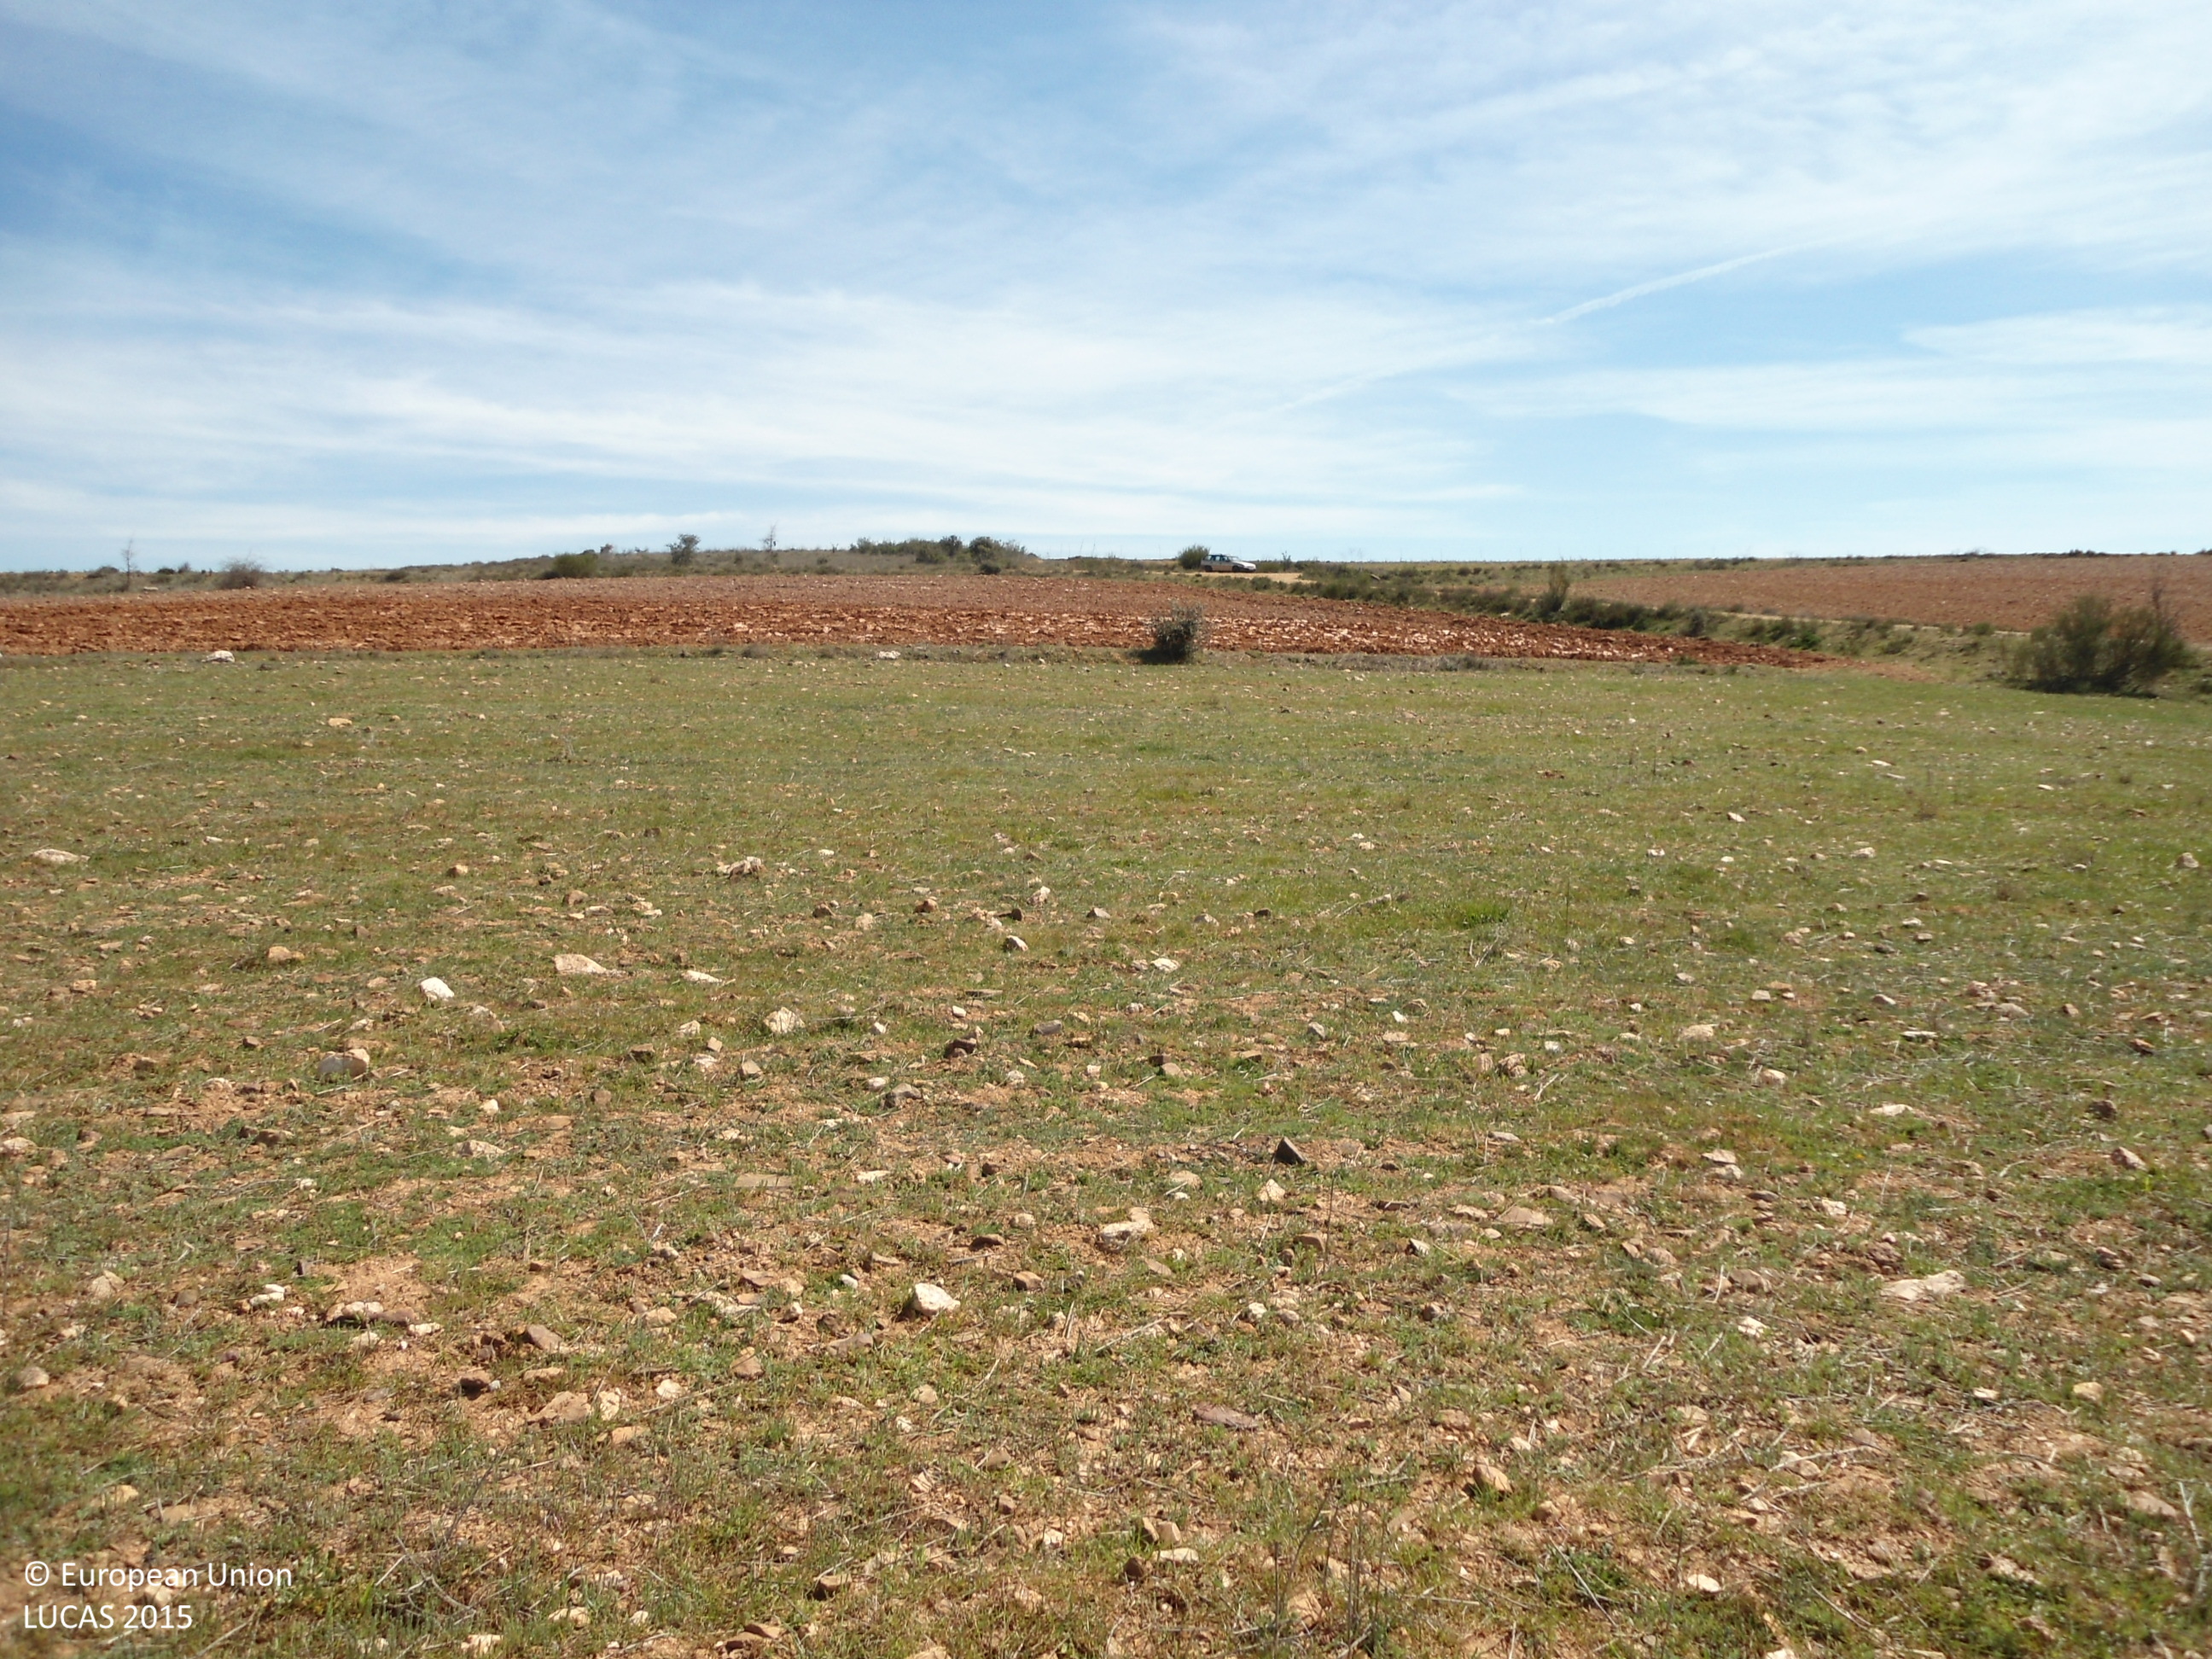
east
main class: Grassland
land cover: Spontaneously vegetated surfaces
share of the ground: > 75 %
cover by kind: herbaceous plants 90 %, unconsolidated bare surface 10 %
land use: Fallow land
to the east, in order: Spontaneously vegetated surfaces; Other bare soil; Grass margins; Tracks; Grass margins; Other bare soil; Fences; Vineyards; Fences; Spontaneously vegetated surfaces
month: April
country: ES
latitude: 41.6943
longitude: -5.9416
